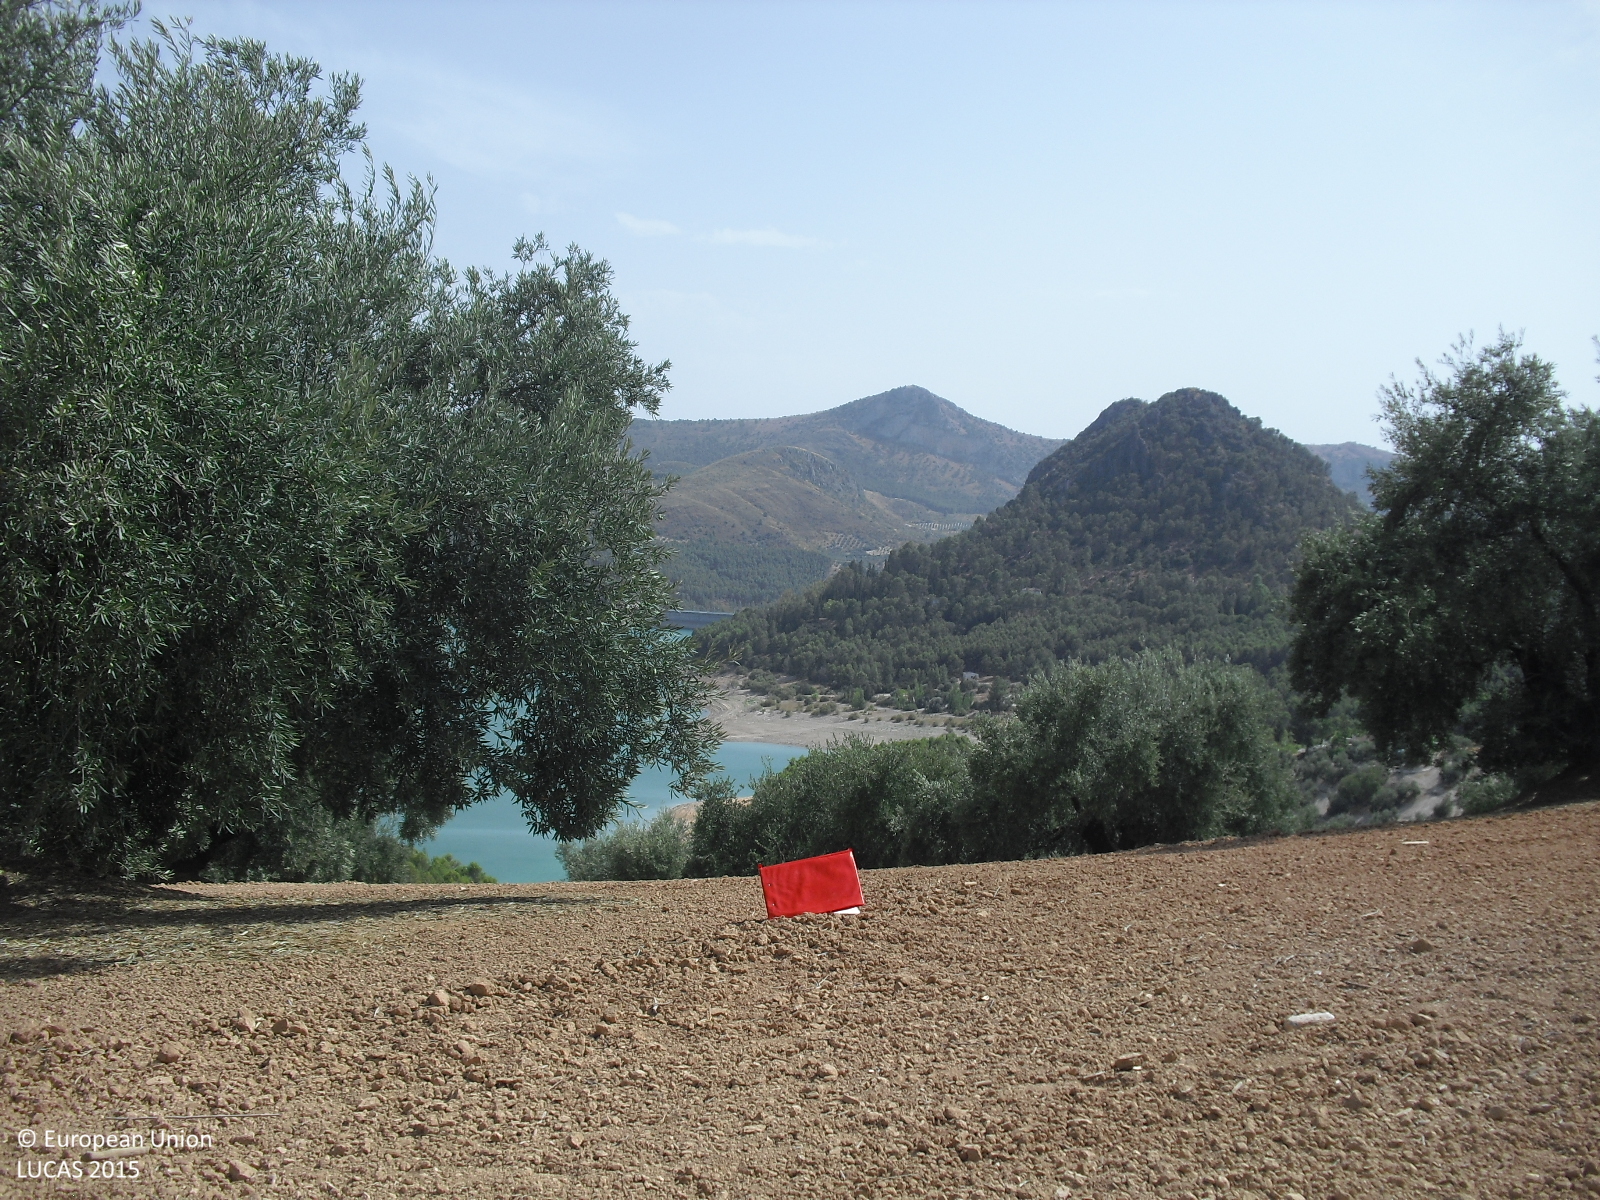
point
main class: Cropland
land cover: Olive groves
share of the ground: 25 - 50 %
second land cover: Other bare soil
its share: > 75 %
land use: Agriculture (excluding fallow land and kitchen gardens)
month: August
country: ES
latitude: 37.2917
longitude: -4.3817
